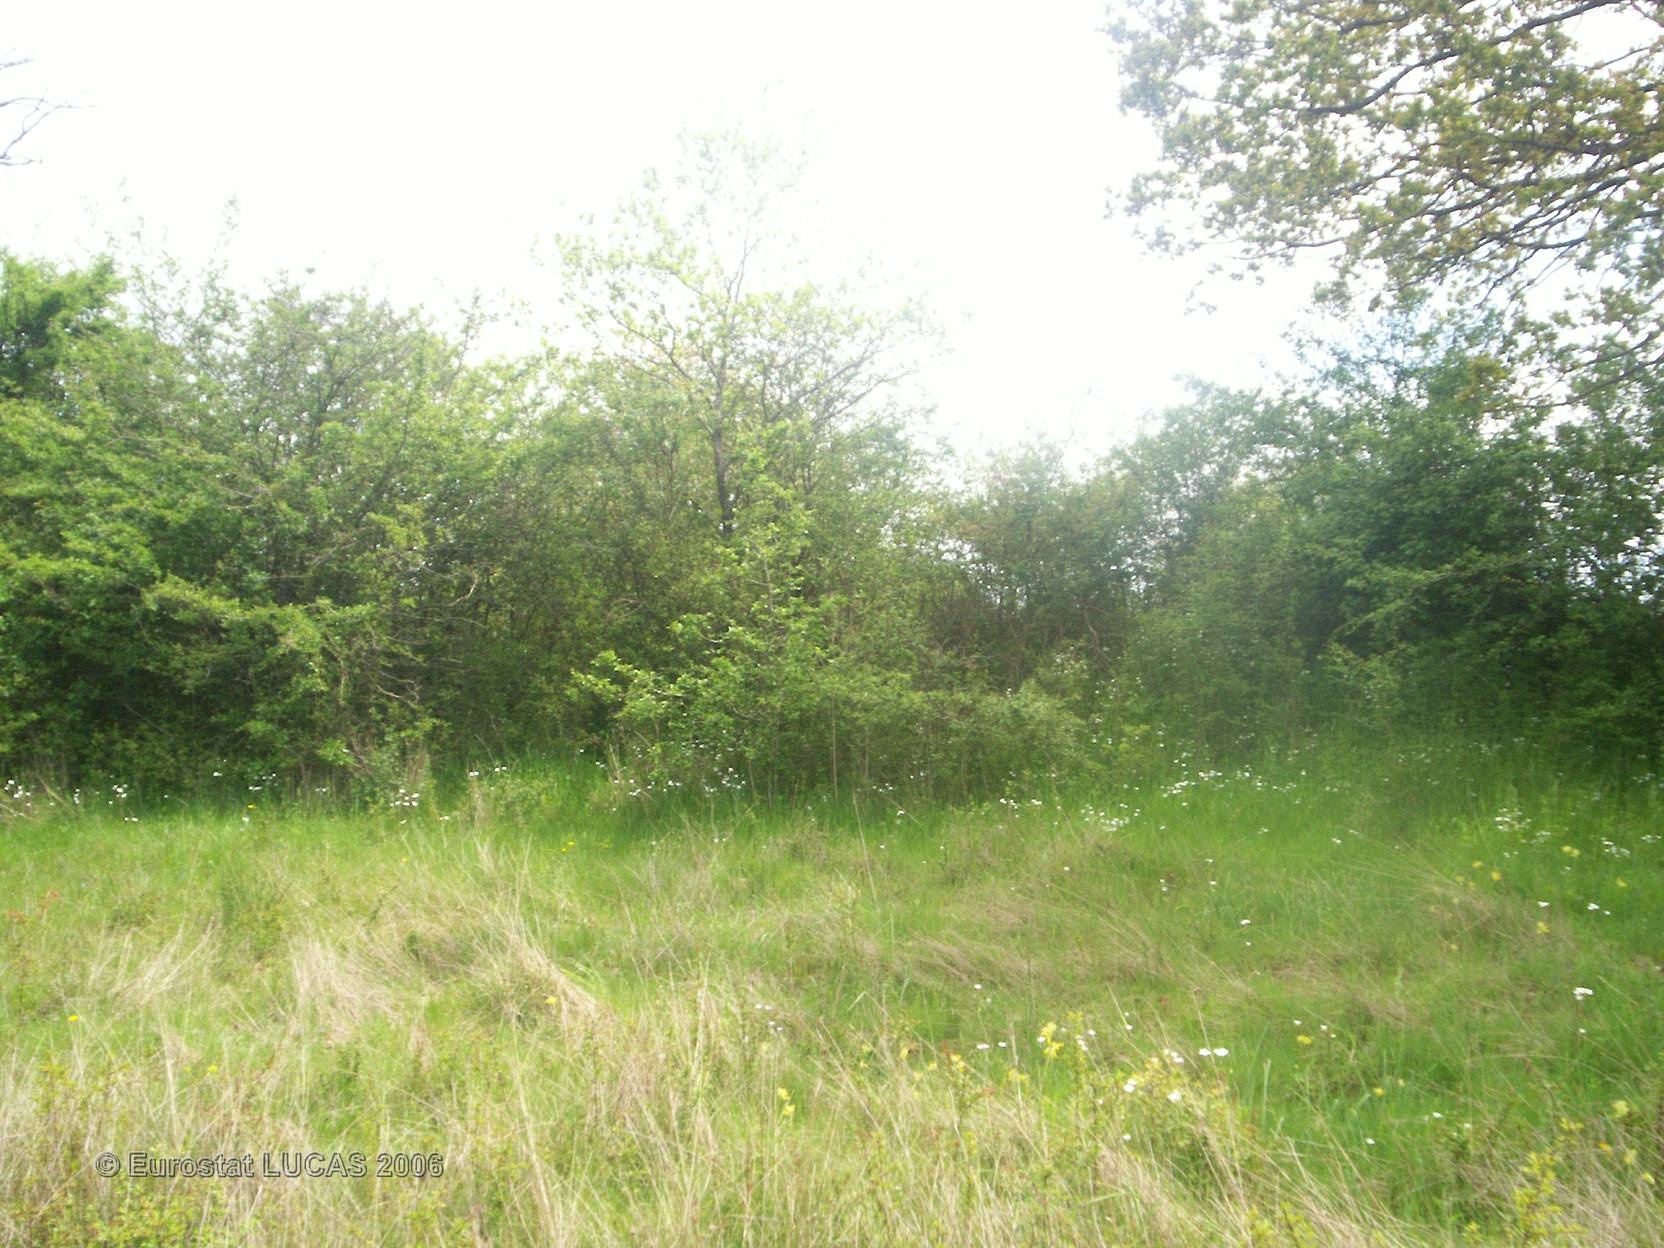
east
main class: Grassland
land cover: Grassland with sparse tree/shrub cover
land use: Unused
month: May
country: FR
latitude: 46.2734
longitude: 3.1077
